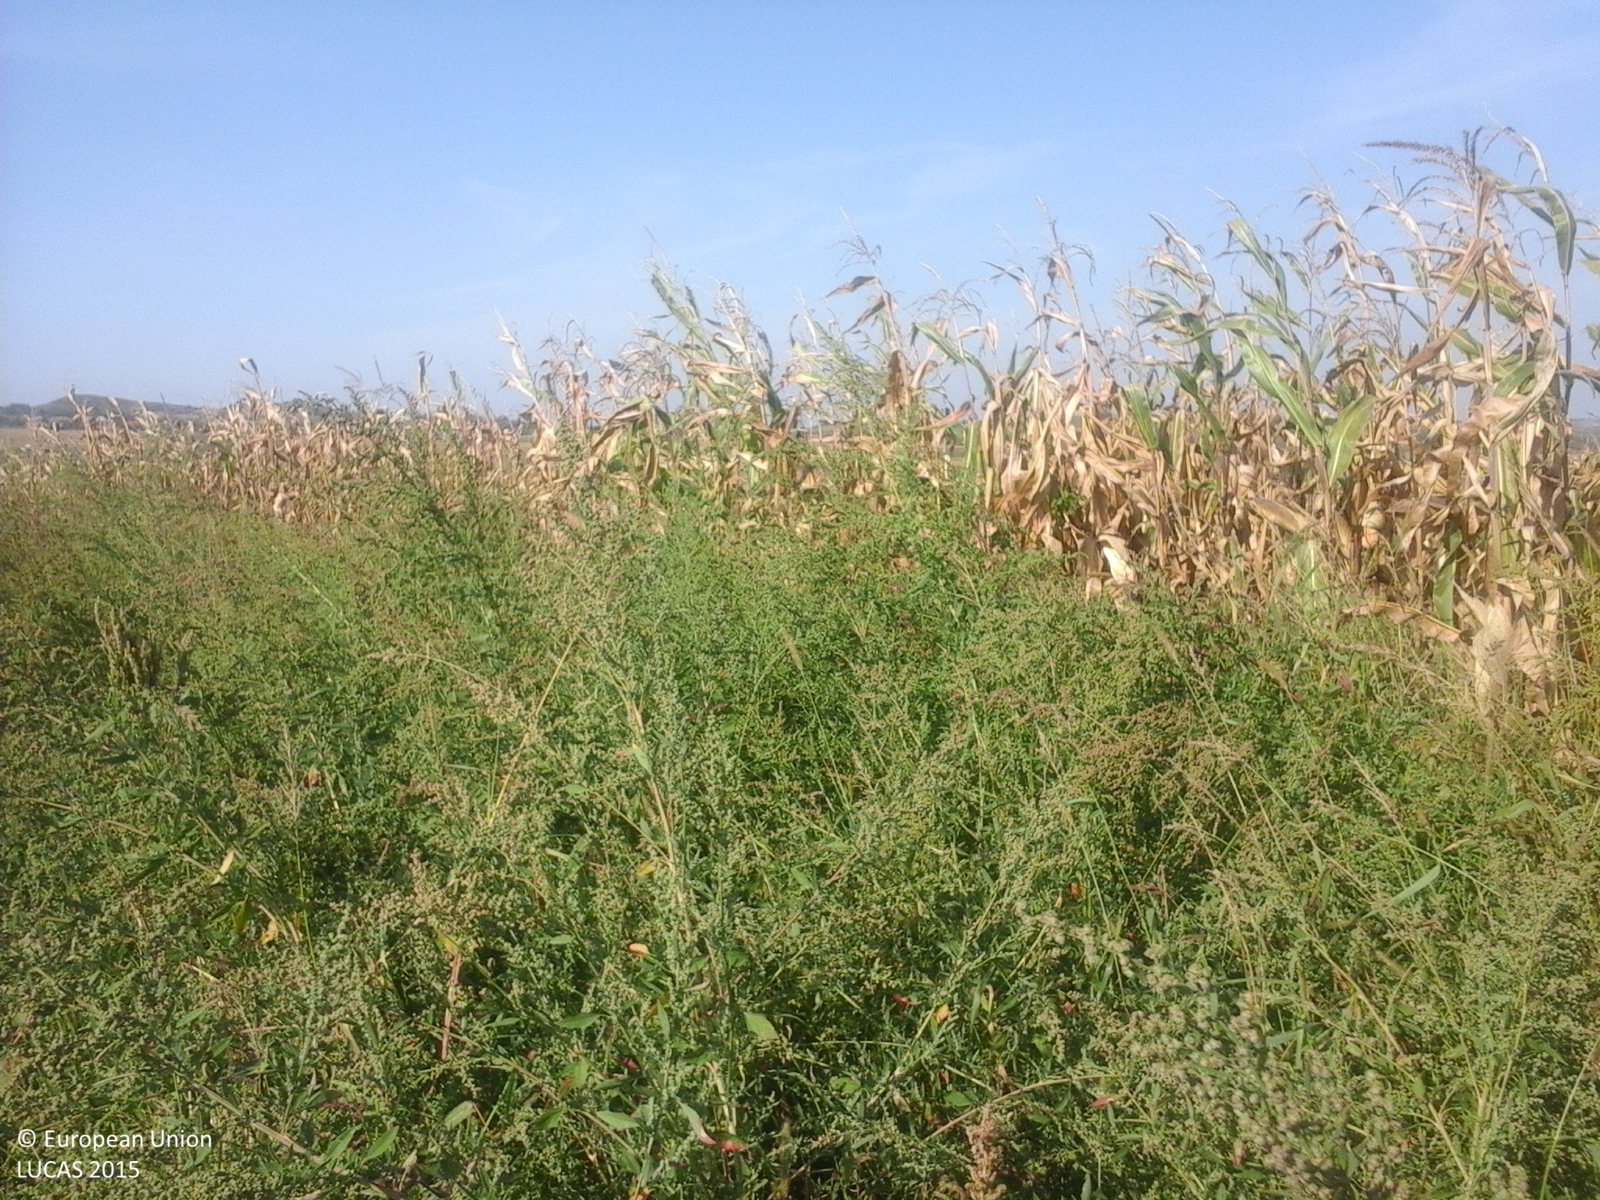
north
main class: Grassland
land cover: Spontaneously vegetated surfaces
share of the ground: > 75 %
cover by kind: herbaceous plants 100 %
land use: Fallow land
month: September
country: RO
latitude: 46.7481
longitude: 23.9395
